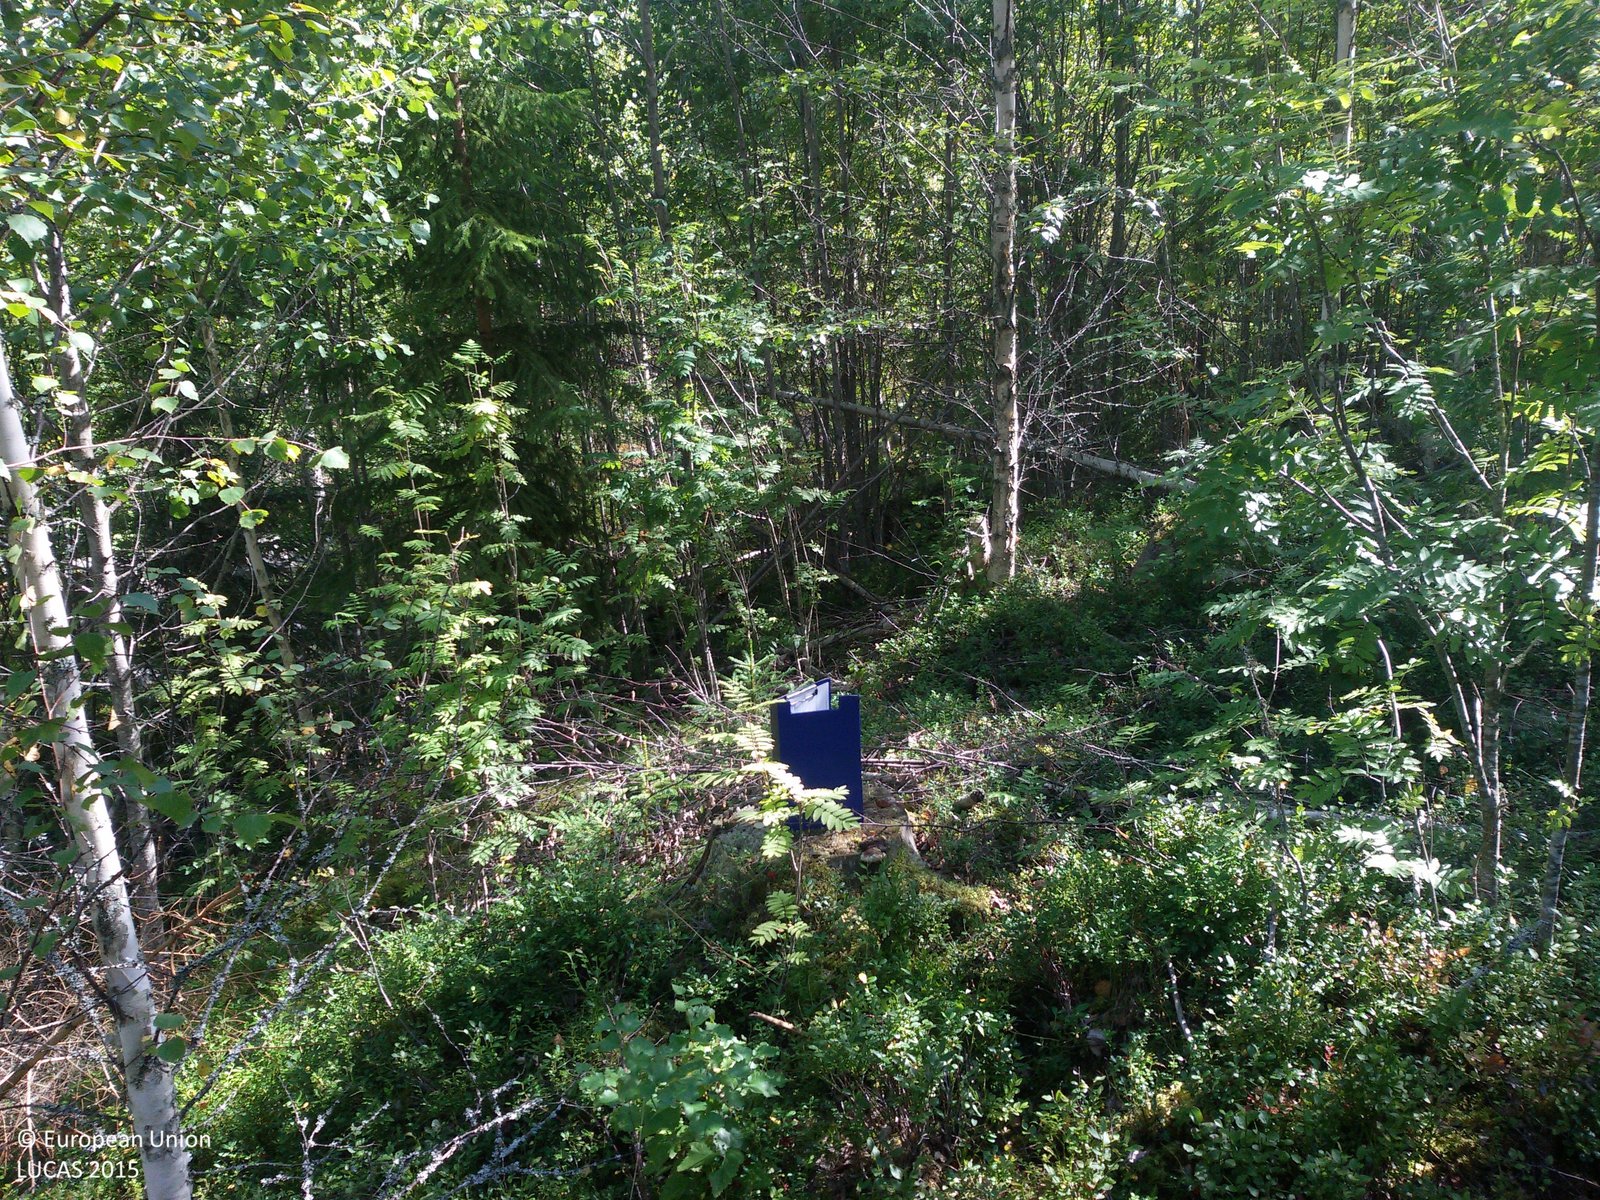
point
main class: Woodland
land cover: Broadleaved woodland
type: boreal forest
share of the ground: 50 - 75 %
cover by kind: broadleaved forest trees 65 %, herbaceous plants 15 %, lichens and mosses 15 %, coniferous forest trees 5 %
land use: Forestry
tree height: > 5 m
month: August
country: SE
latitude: 60.7610
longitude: 15.9149
